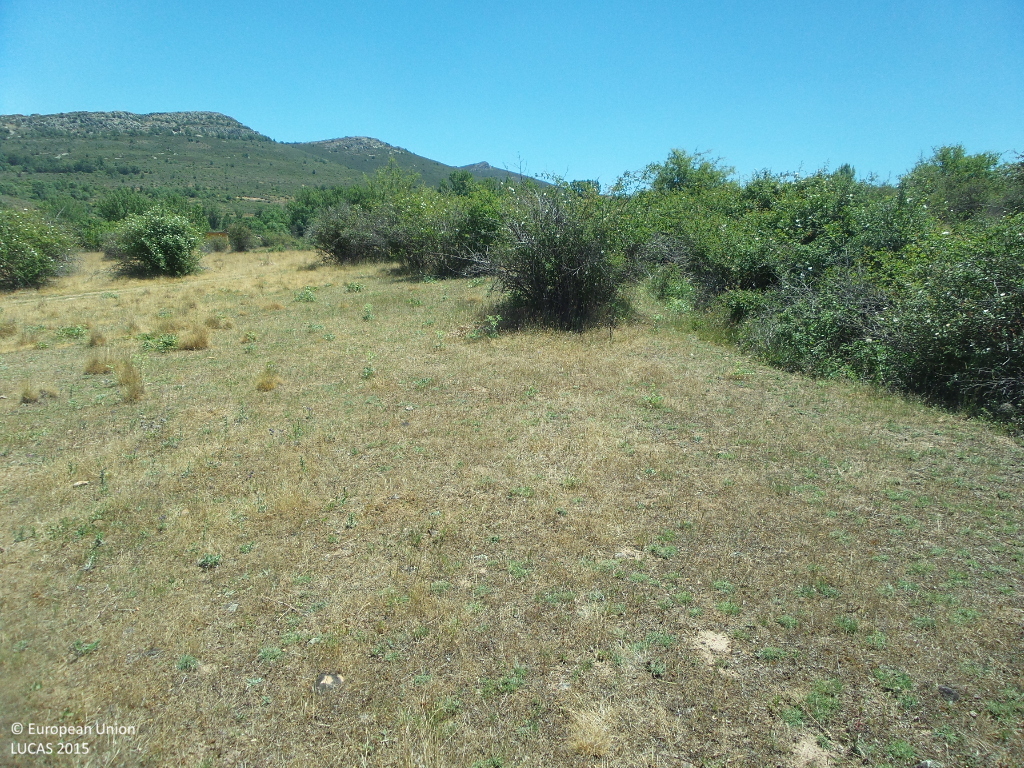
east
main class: Shrubland
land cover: Shrubland without tree cover
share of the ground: 10 - 25 %
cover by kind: herbaceous plants 70 %, shrubs 20 %, unconsolidated bare surface 10 %
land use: Semi-natural and natural areas not in use
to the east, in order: Shrubland without tree cover; Tracks; Grassland without tree/shrub cover; Grassland with sparse tree/shrub cover; Broadleaved woodland; Rivers and streams; Broadleaved woodland; Grassland with sparse tree/shrub cover
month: June
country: ES
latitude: 41.1649
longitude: -2.9203
